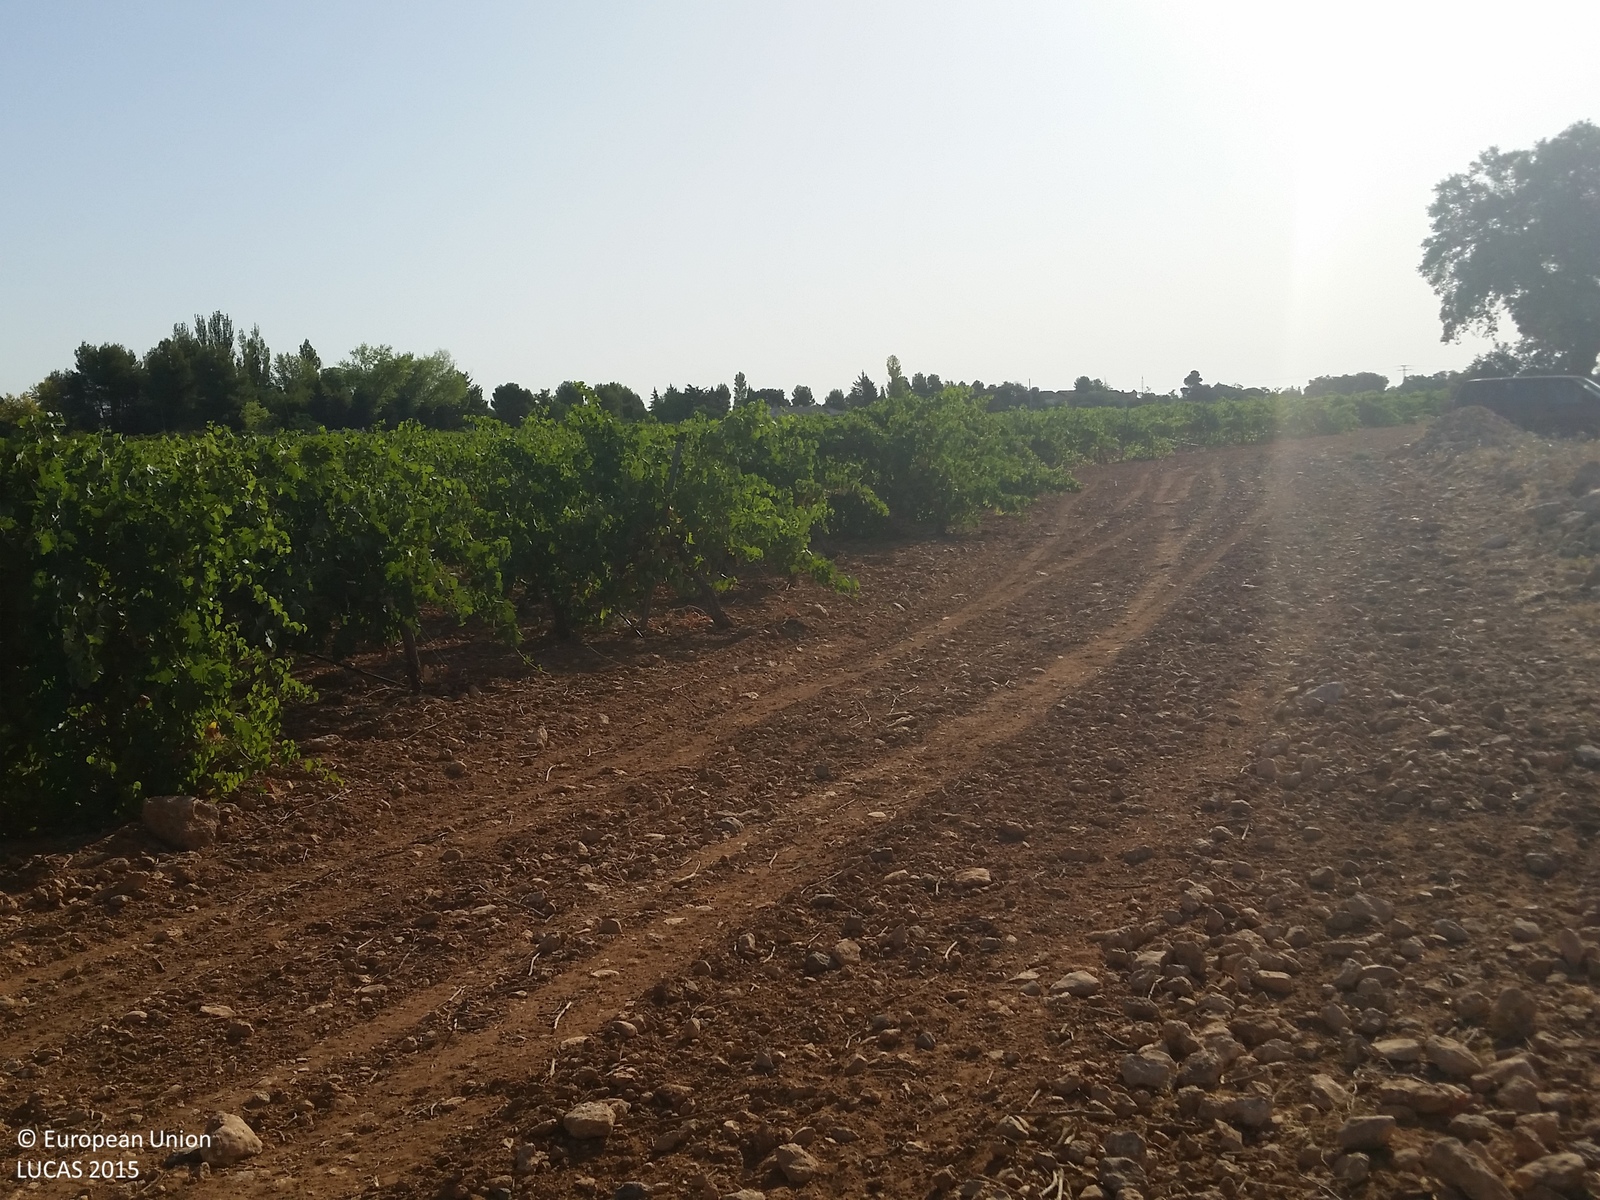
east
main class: Cropland
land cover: Vineyards
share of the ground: 50 - 75 %
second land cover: Other bare soil
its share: > 75 %
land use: Agriculture (excluding fallow land and kitchen gardens)
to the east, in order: Vineyards; Other bare soil
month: July
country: ES
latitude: 39.2971
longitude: -2.6615
